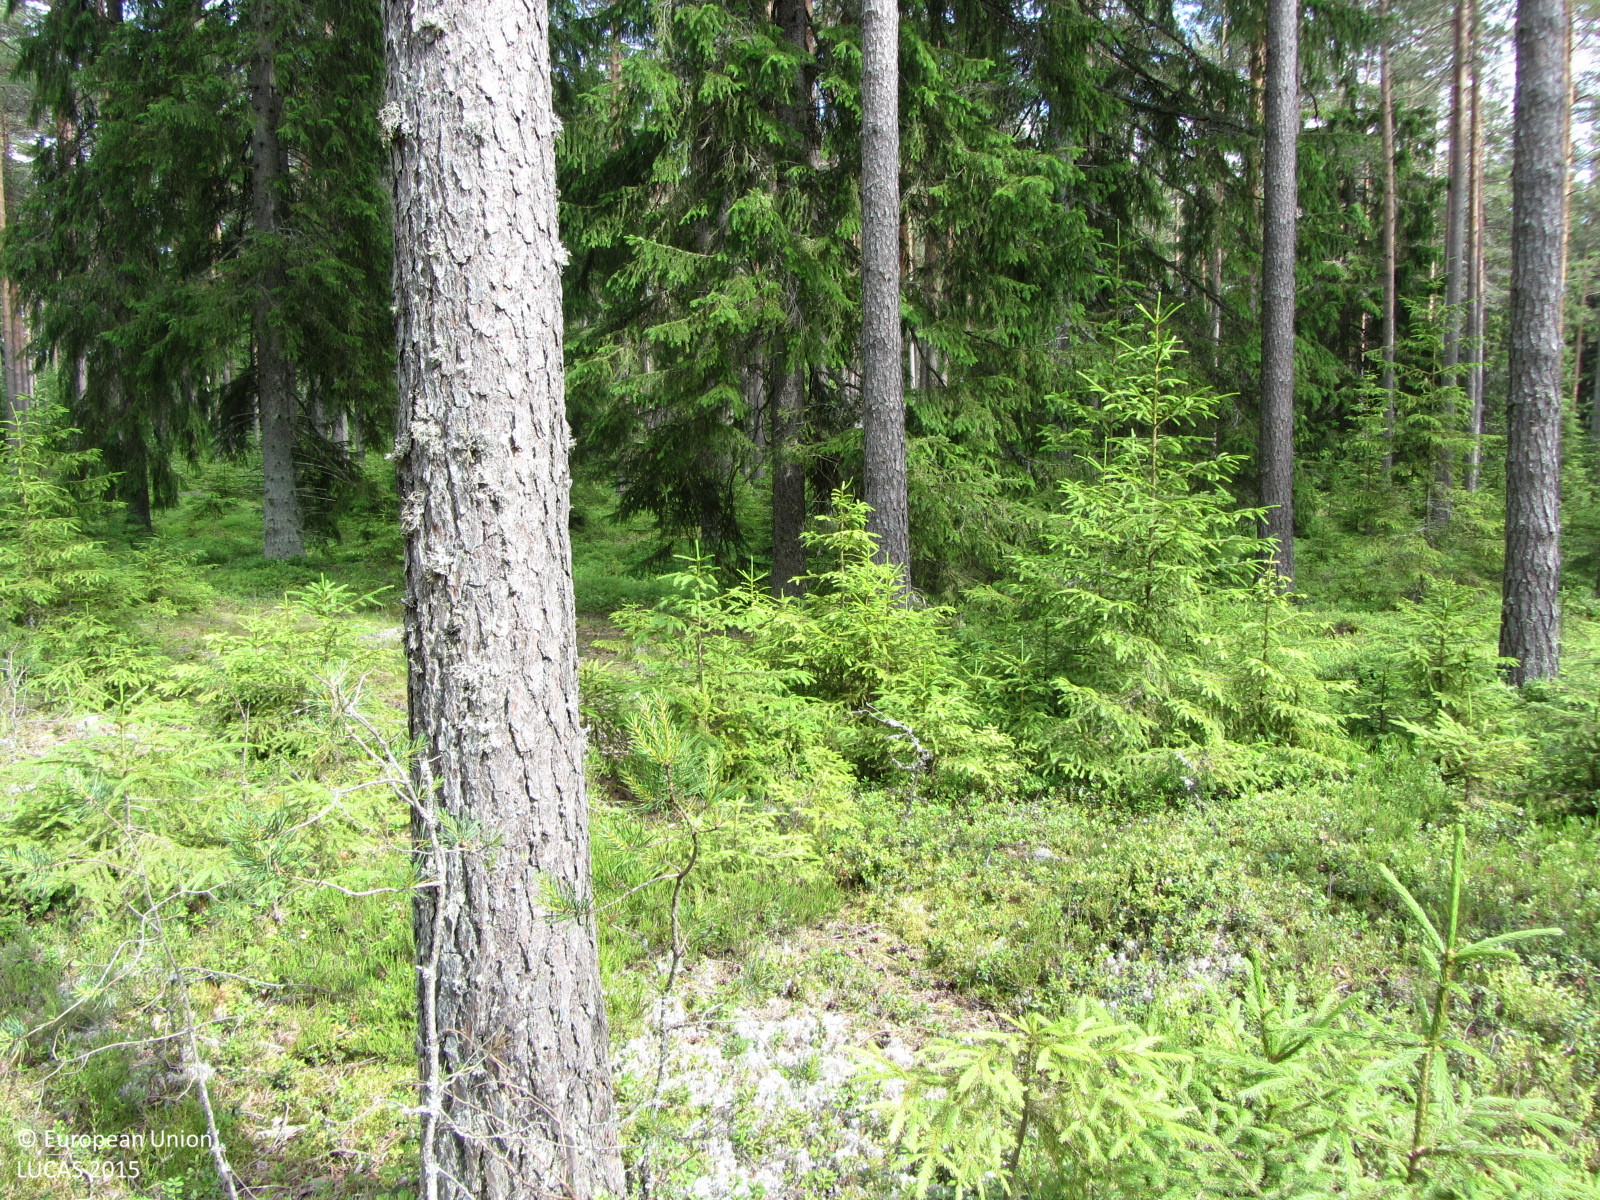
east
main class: Woodland
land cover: Other coniferous woodland
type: boreal forest
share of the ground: > 75 %
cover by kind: coniferous forest trees 75 %, shrubs 15 %, lichens and mosses 10 %
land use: Forestry
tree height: > 5 m
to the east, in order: Other coniferous woodland; Ditches and canals; Paved roads, cycling and walking lanes; Ditches and canals; Other coniferous woodland
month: June
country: FI
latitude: 60.1057
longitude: 23.1969
